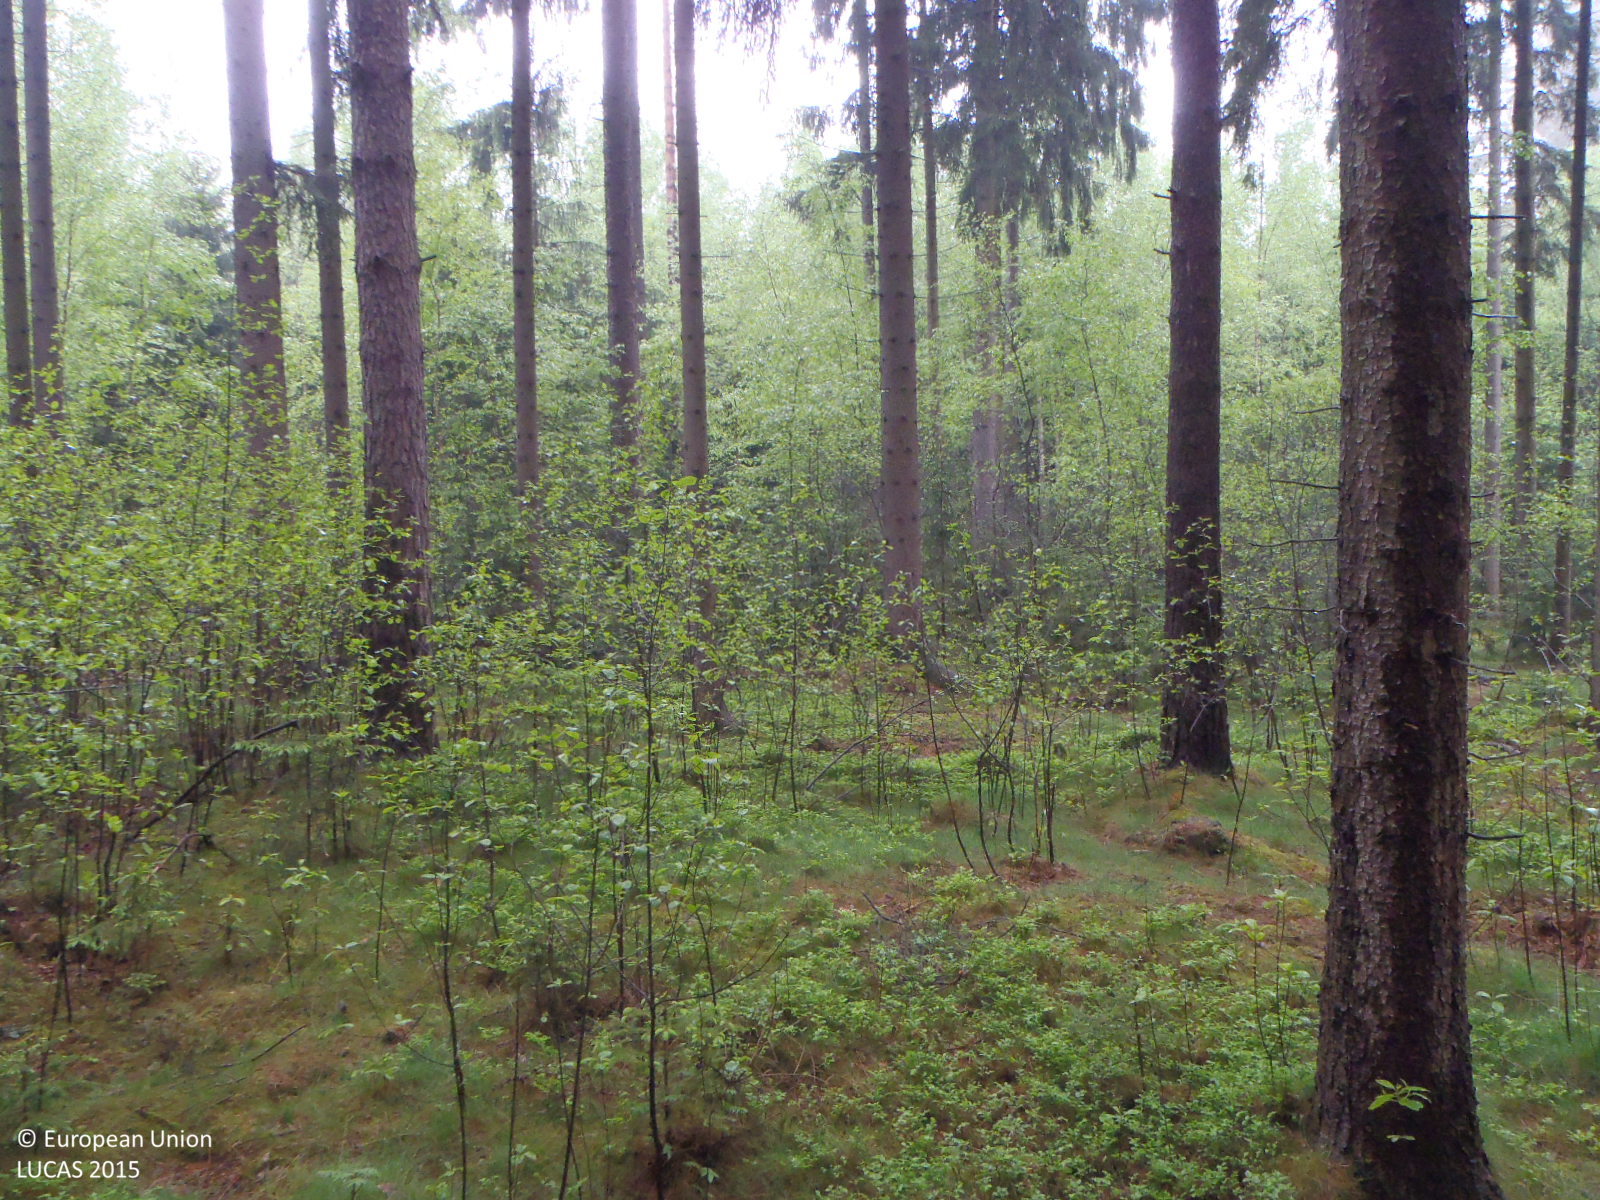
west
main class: Woodland
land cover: Other coniferous woodland
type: hemiboreal forest and nemoral coniferous forest and mixed broadleaved-coniferous forest
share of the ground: > 75 %
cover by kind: coniferous forest trees 75 %, broadleaved forest trees 10 %, shrubs 5 %, herbaceous plants 5 %, lichens and mosses 5 %
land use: Forestry
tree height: > 5 m
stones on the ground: 10 - 25 %
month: May
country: CZ
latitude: 48.7835
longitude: 14.4240
